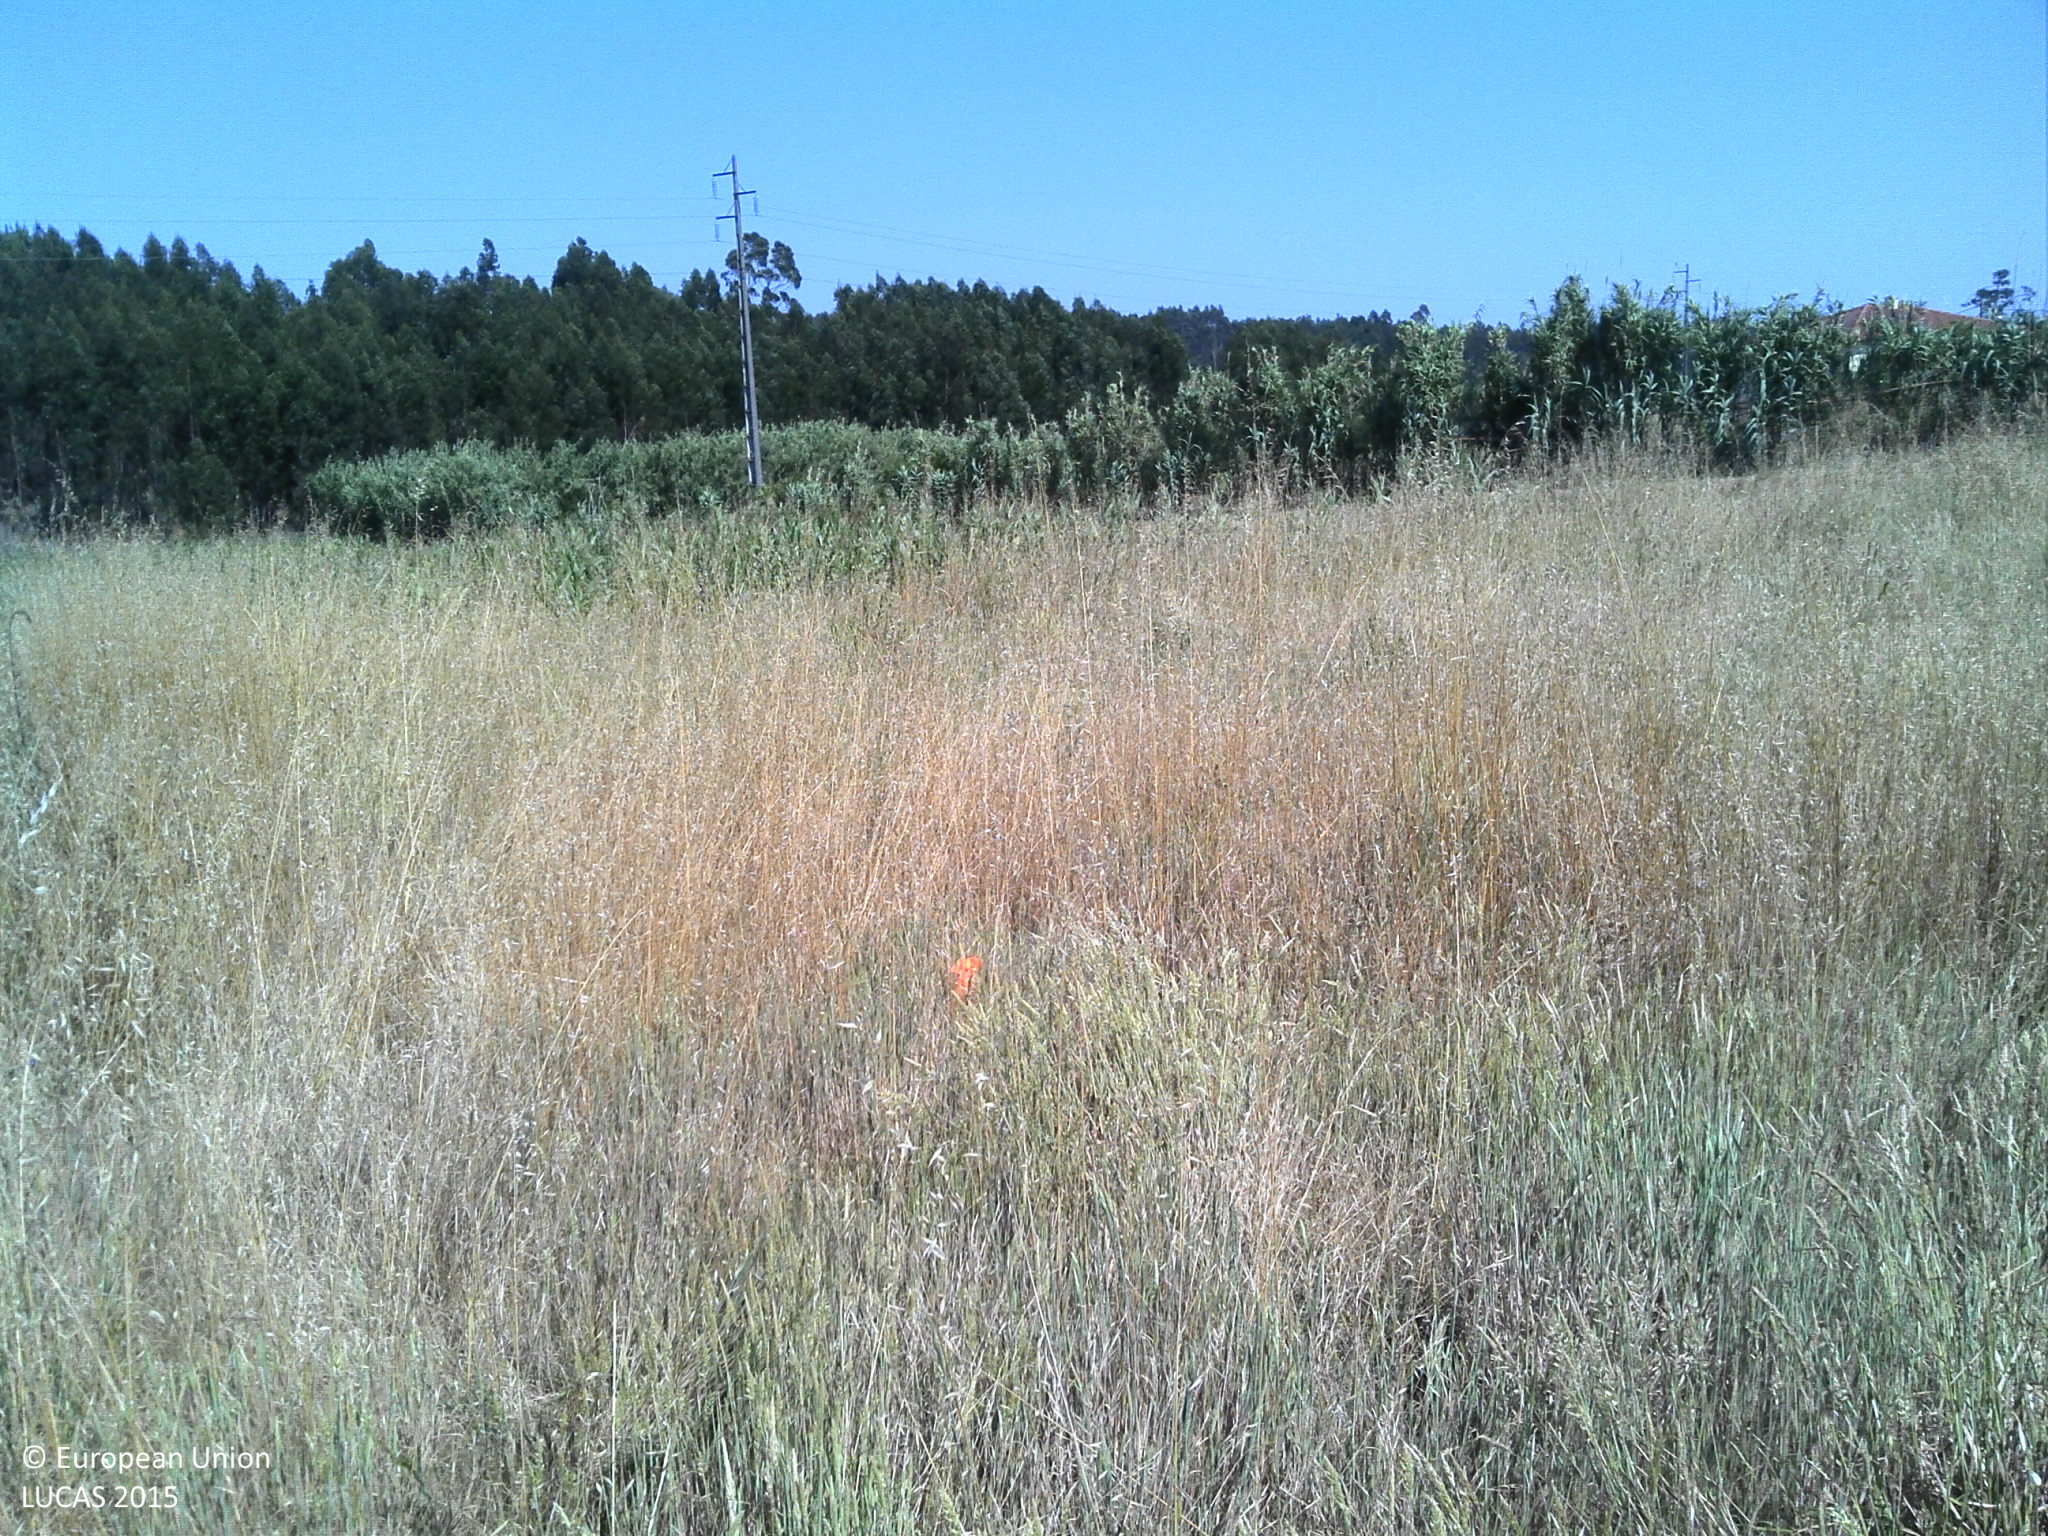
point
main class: Grassland
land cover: Spontaneously vegetated surfaces
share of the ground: > 75 %
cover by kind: herbaceous plants 80 %, unconsolidated bare surface 20 %
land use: Fallow land
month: June
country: PT
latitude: 39.1712
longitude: -9.2673
